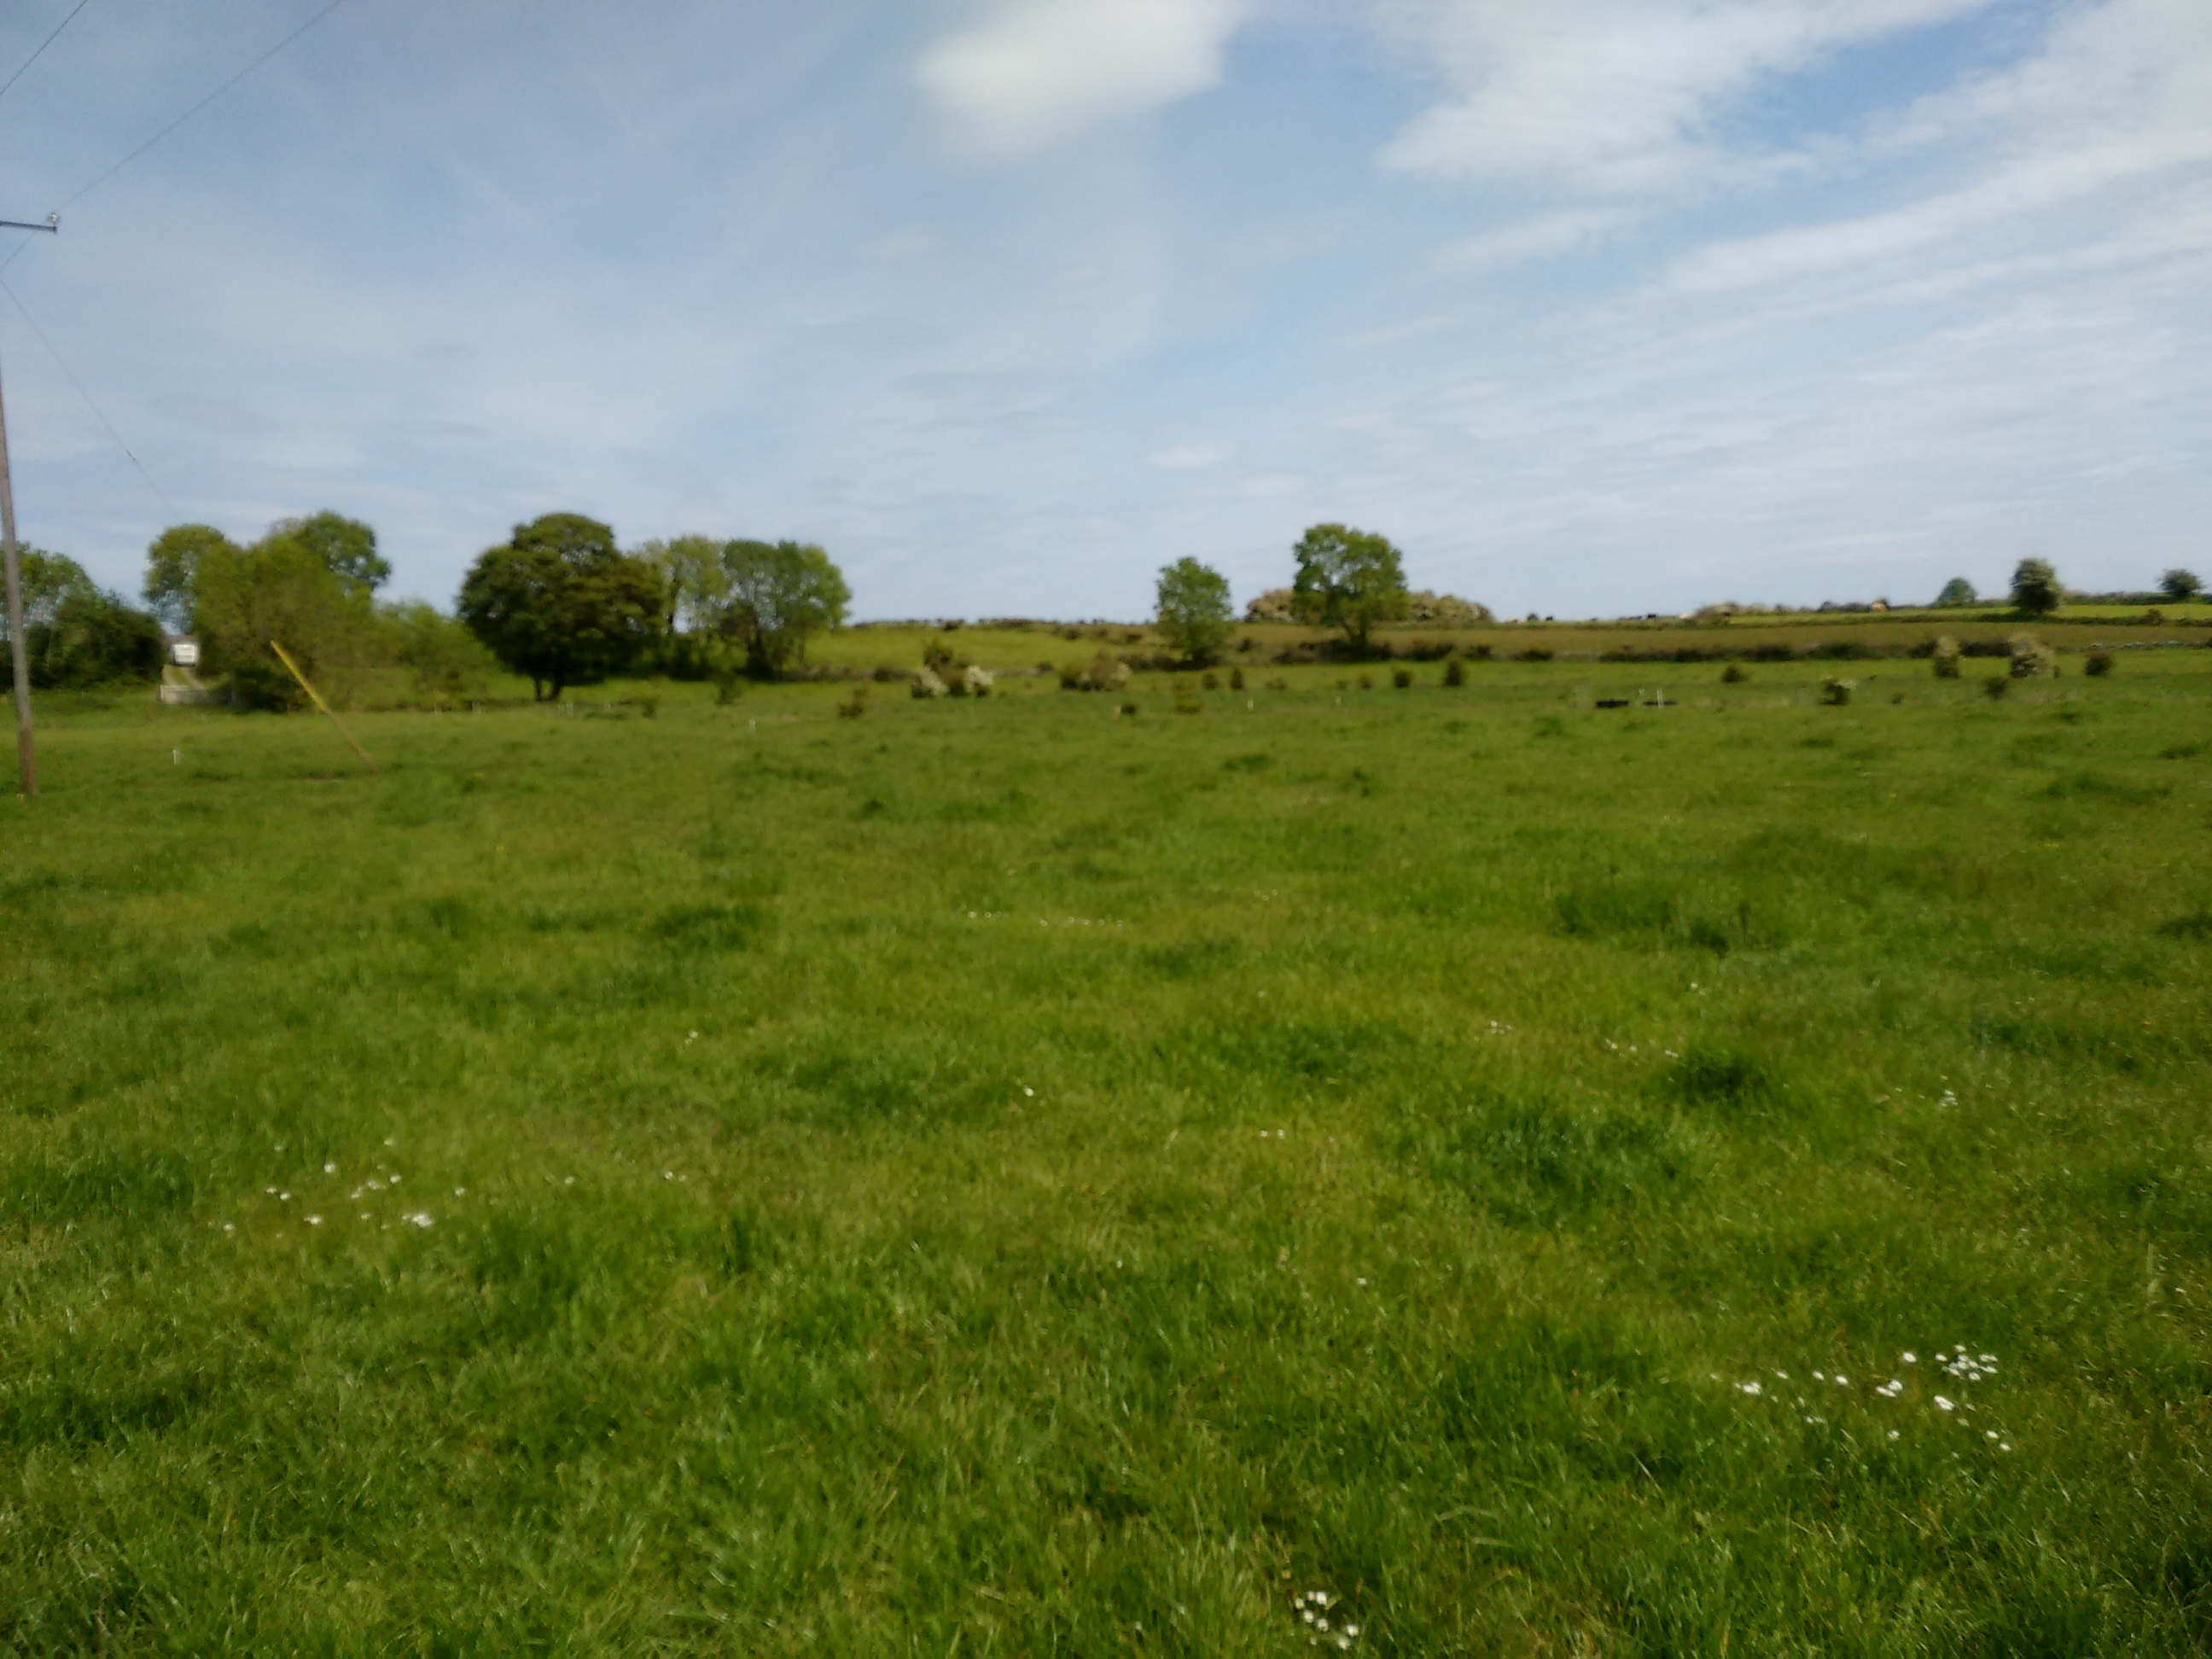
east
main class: Grassland
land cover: Grassland without tree/shrub cover
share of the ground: > 75 %
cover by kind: herbaceous plants 100 %
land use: Agriculture (excluding fallow land and kitchen gardens)
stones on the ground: < 10 %
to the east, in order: Grassland without tree/shrub cover; Electric lines; Grassland without tree/shrub cover; Ditches and canals; Fences; Grassland without tree/shrub cover; Ditches and canals; Fences; Grassland without tree/shrub cover; Dry stone walls; Abandoned hedges; Grassland without tree/shrub cover
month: June
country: IE
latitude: 53.4932
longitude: -8.7266
